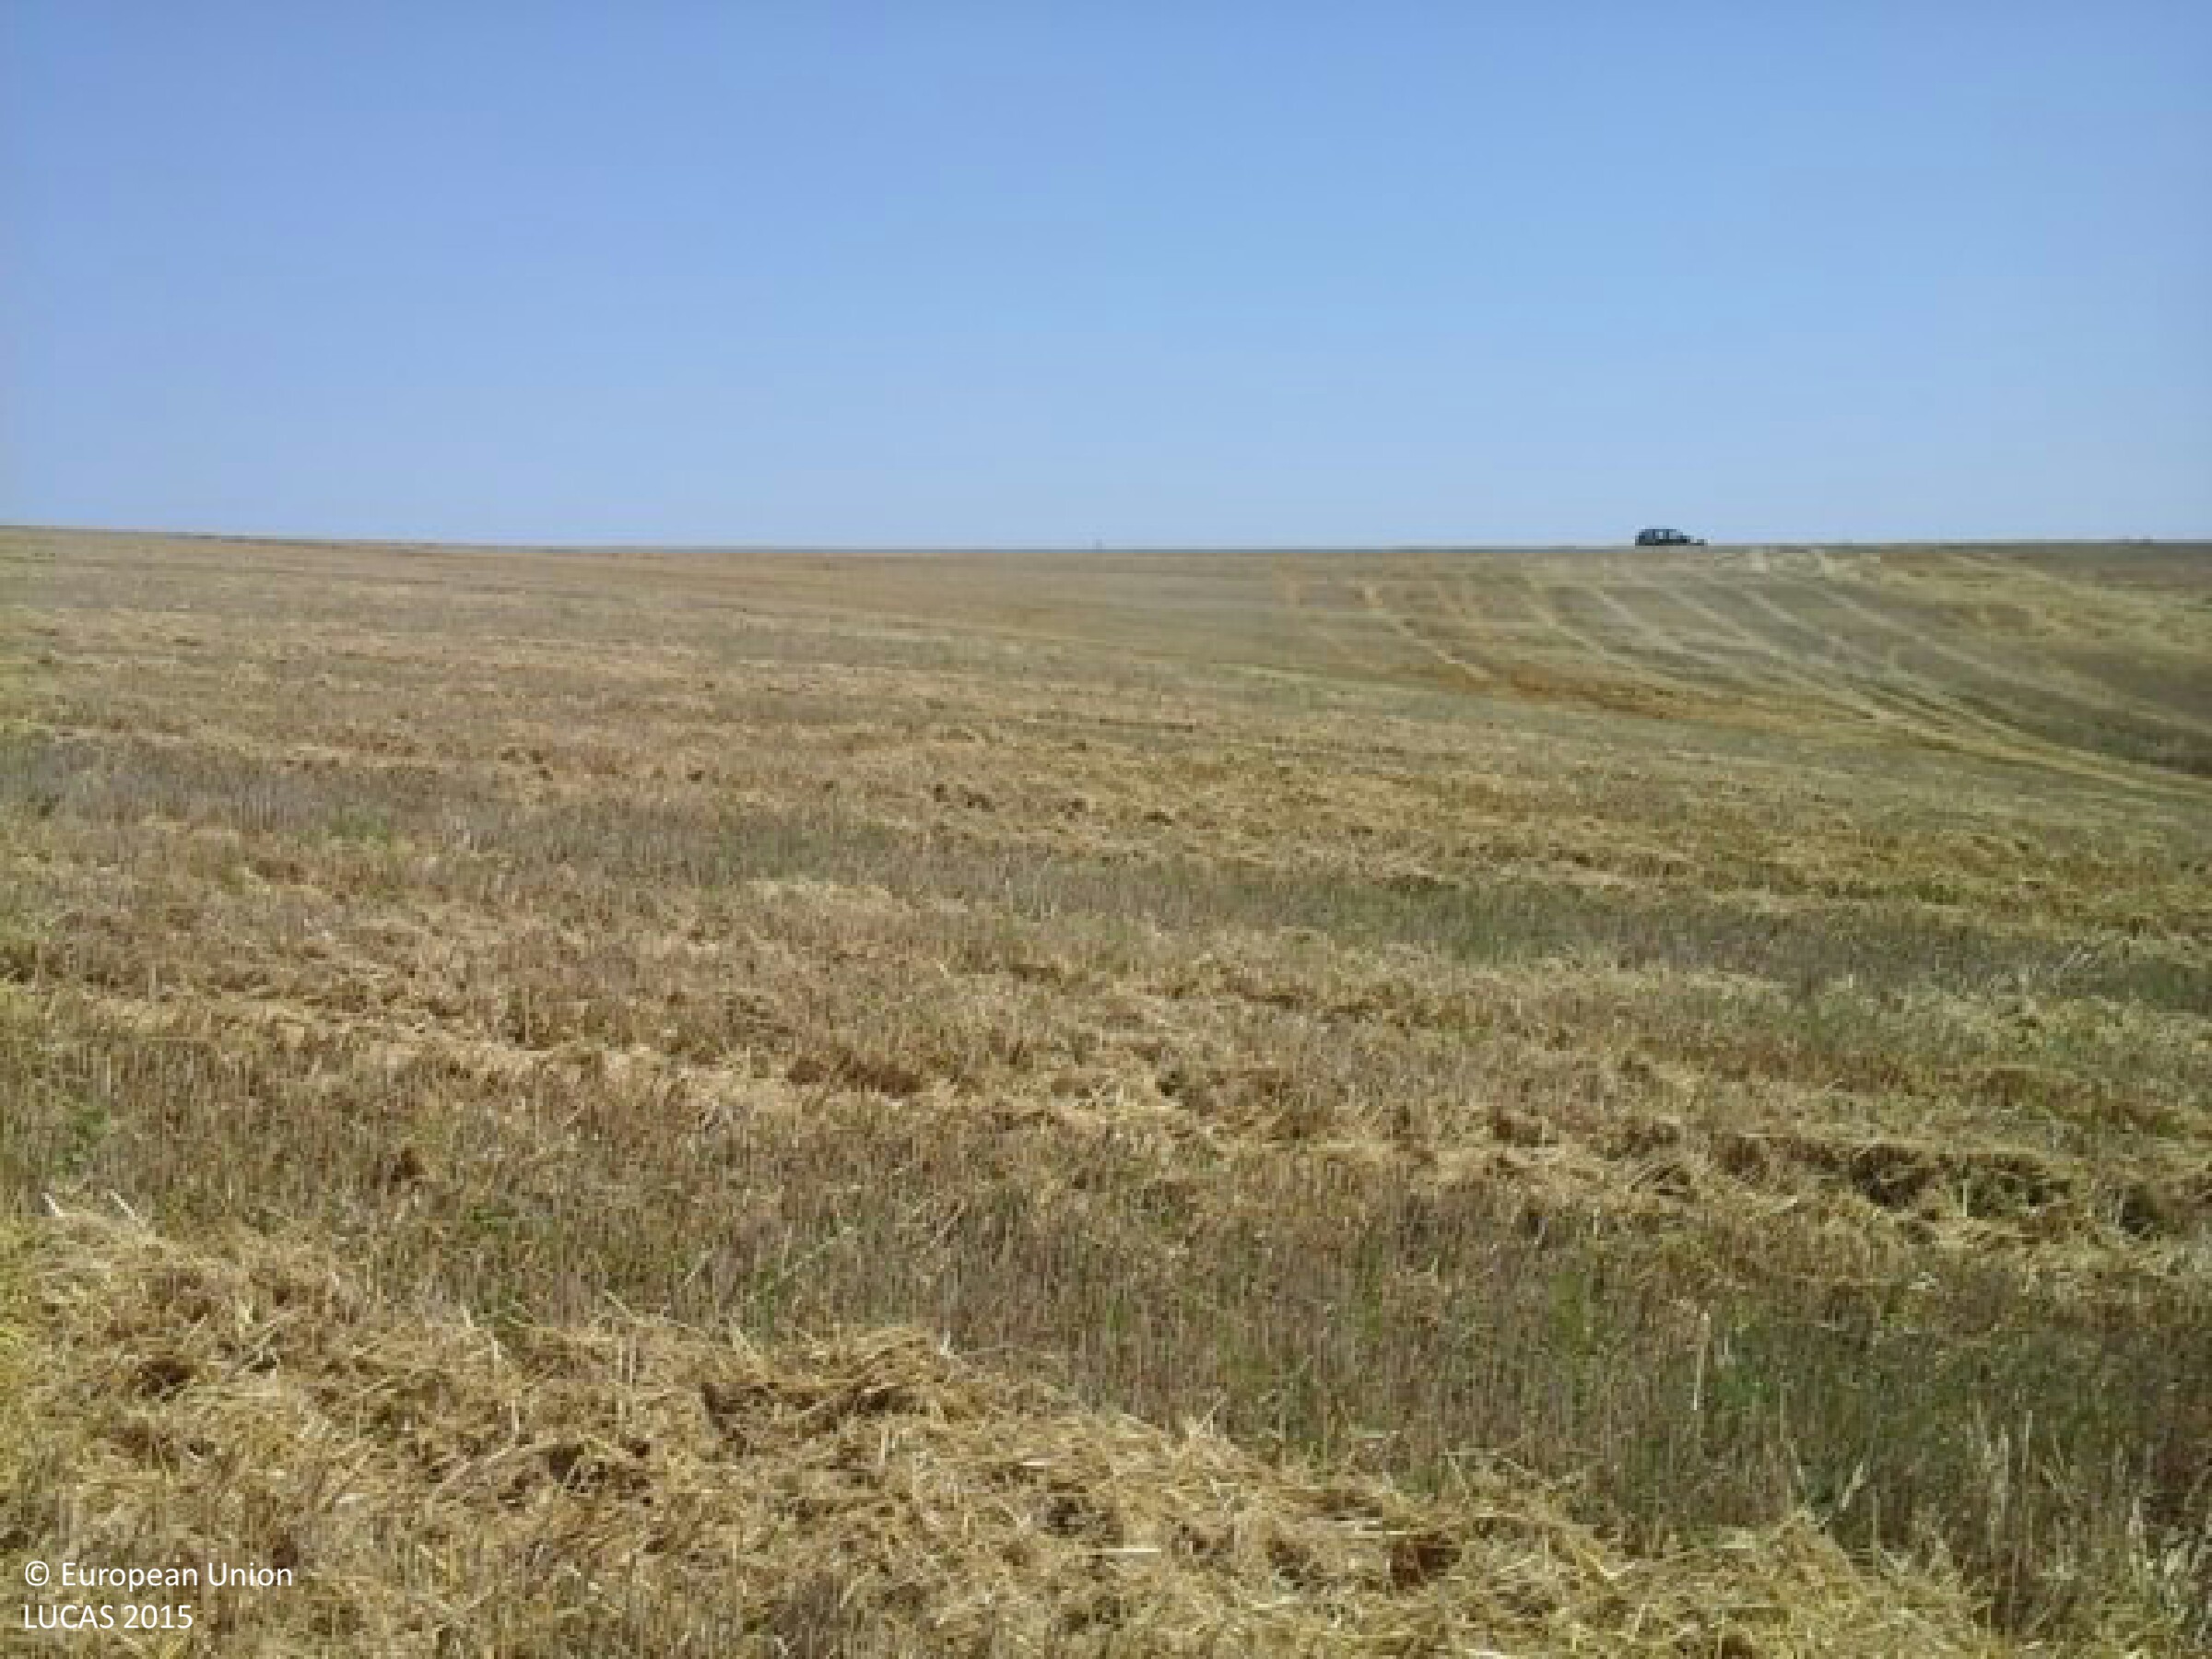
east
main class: Cropland
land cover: Common wheat
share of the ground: > 75 %
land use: Agriculture (excluding fallow land and kitchen gardens)
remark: Harvested field
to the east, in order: Common wheat; Tracks; Common wheat
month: July
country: HU
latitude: 46.2829
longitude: 17.0238
